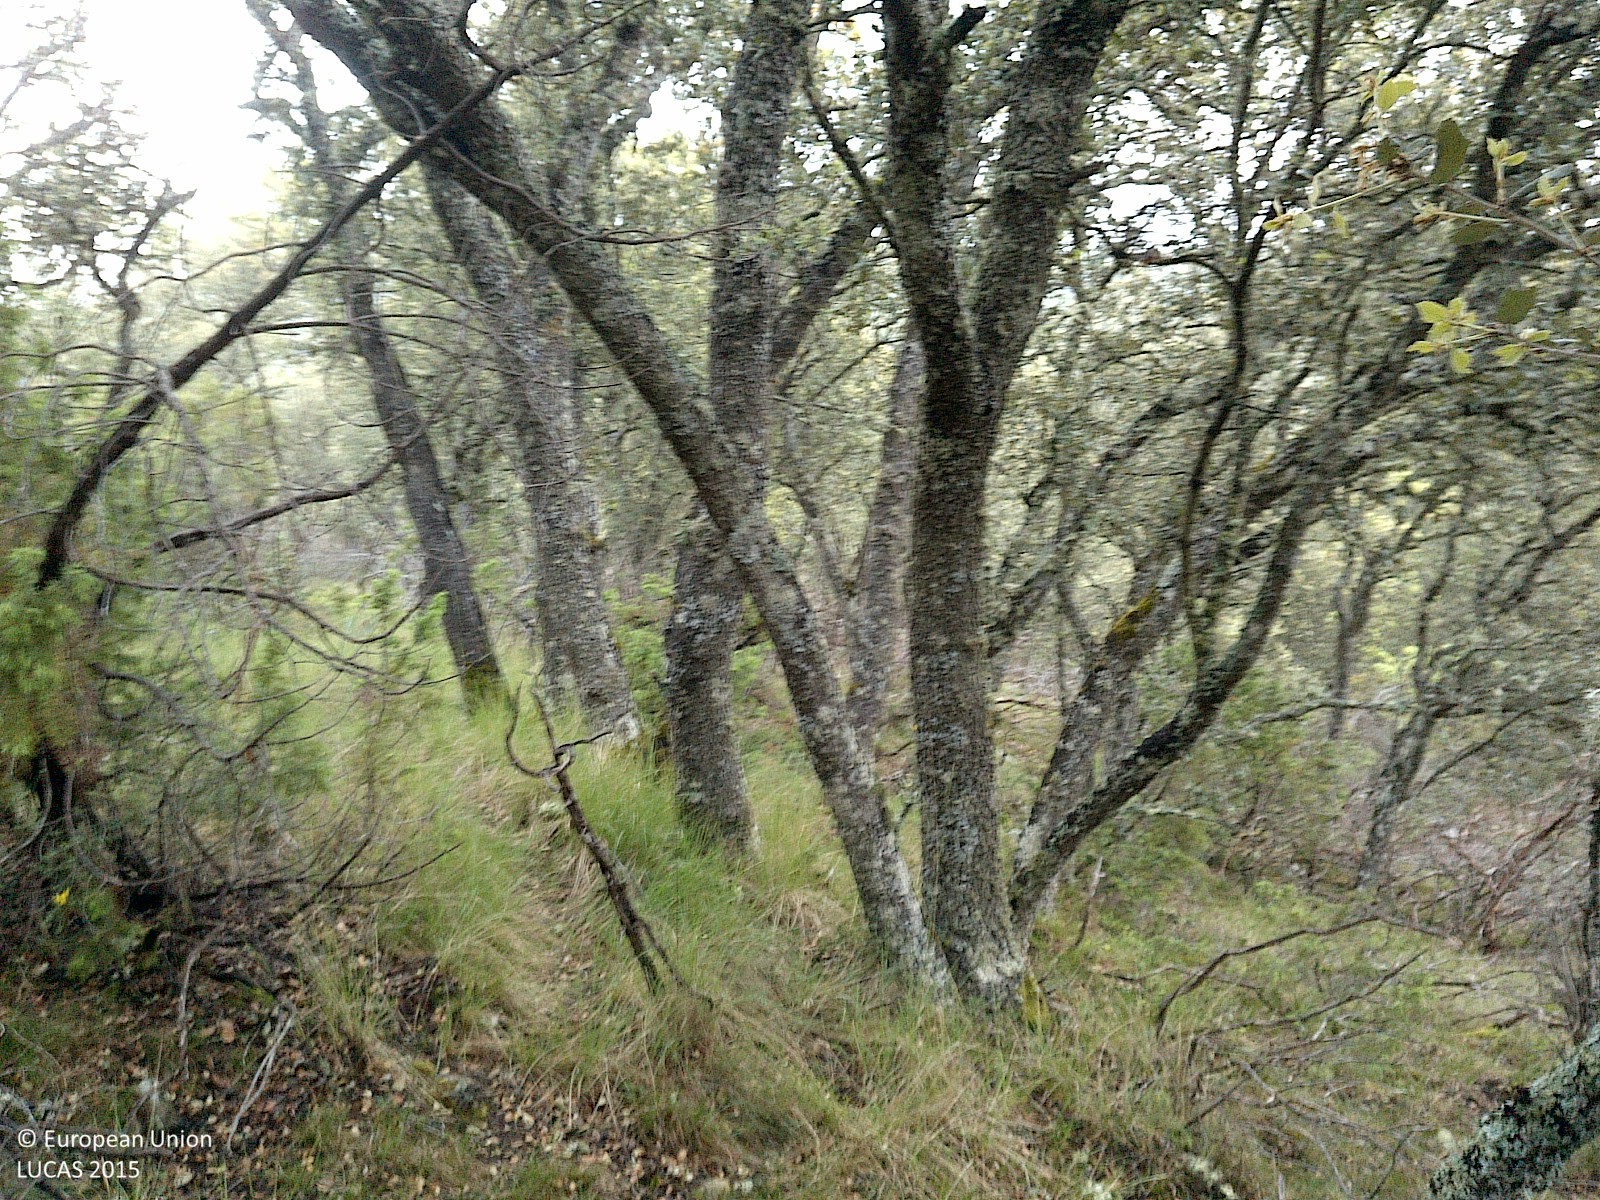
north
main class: Woodland
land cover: Broadleaved woodland
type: broadleaved evergreen forest
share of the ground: > 75 %
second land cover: Grassland without tree/shrub cover
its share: 25 - 50 %
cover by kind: broadleaved forest trees 80 %, shrubs 15 %, herbaceous plants 5 %
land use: Forestry
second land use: Agriculture (excluding fallow land and kitchen gardens)
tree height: > 5 m
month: May
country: ES
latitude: 41.8065
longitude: -2.1799
